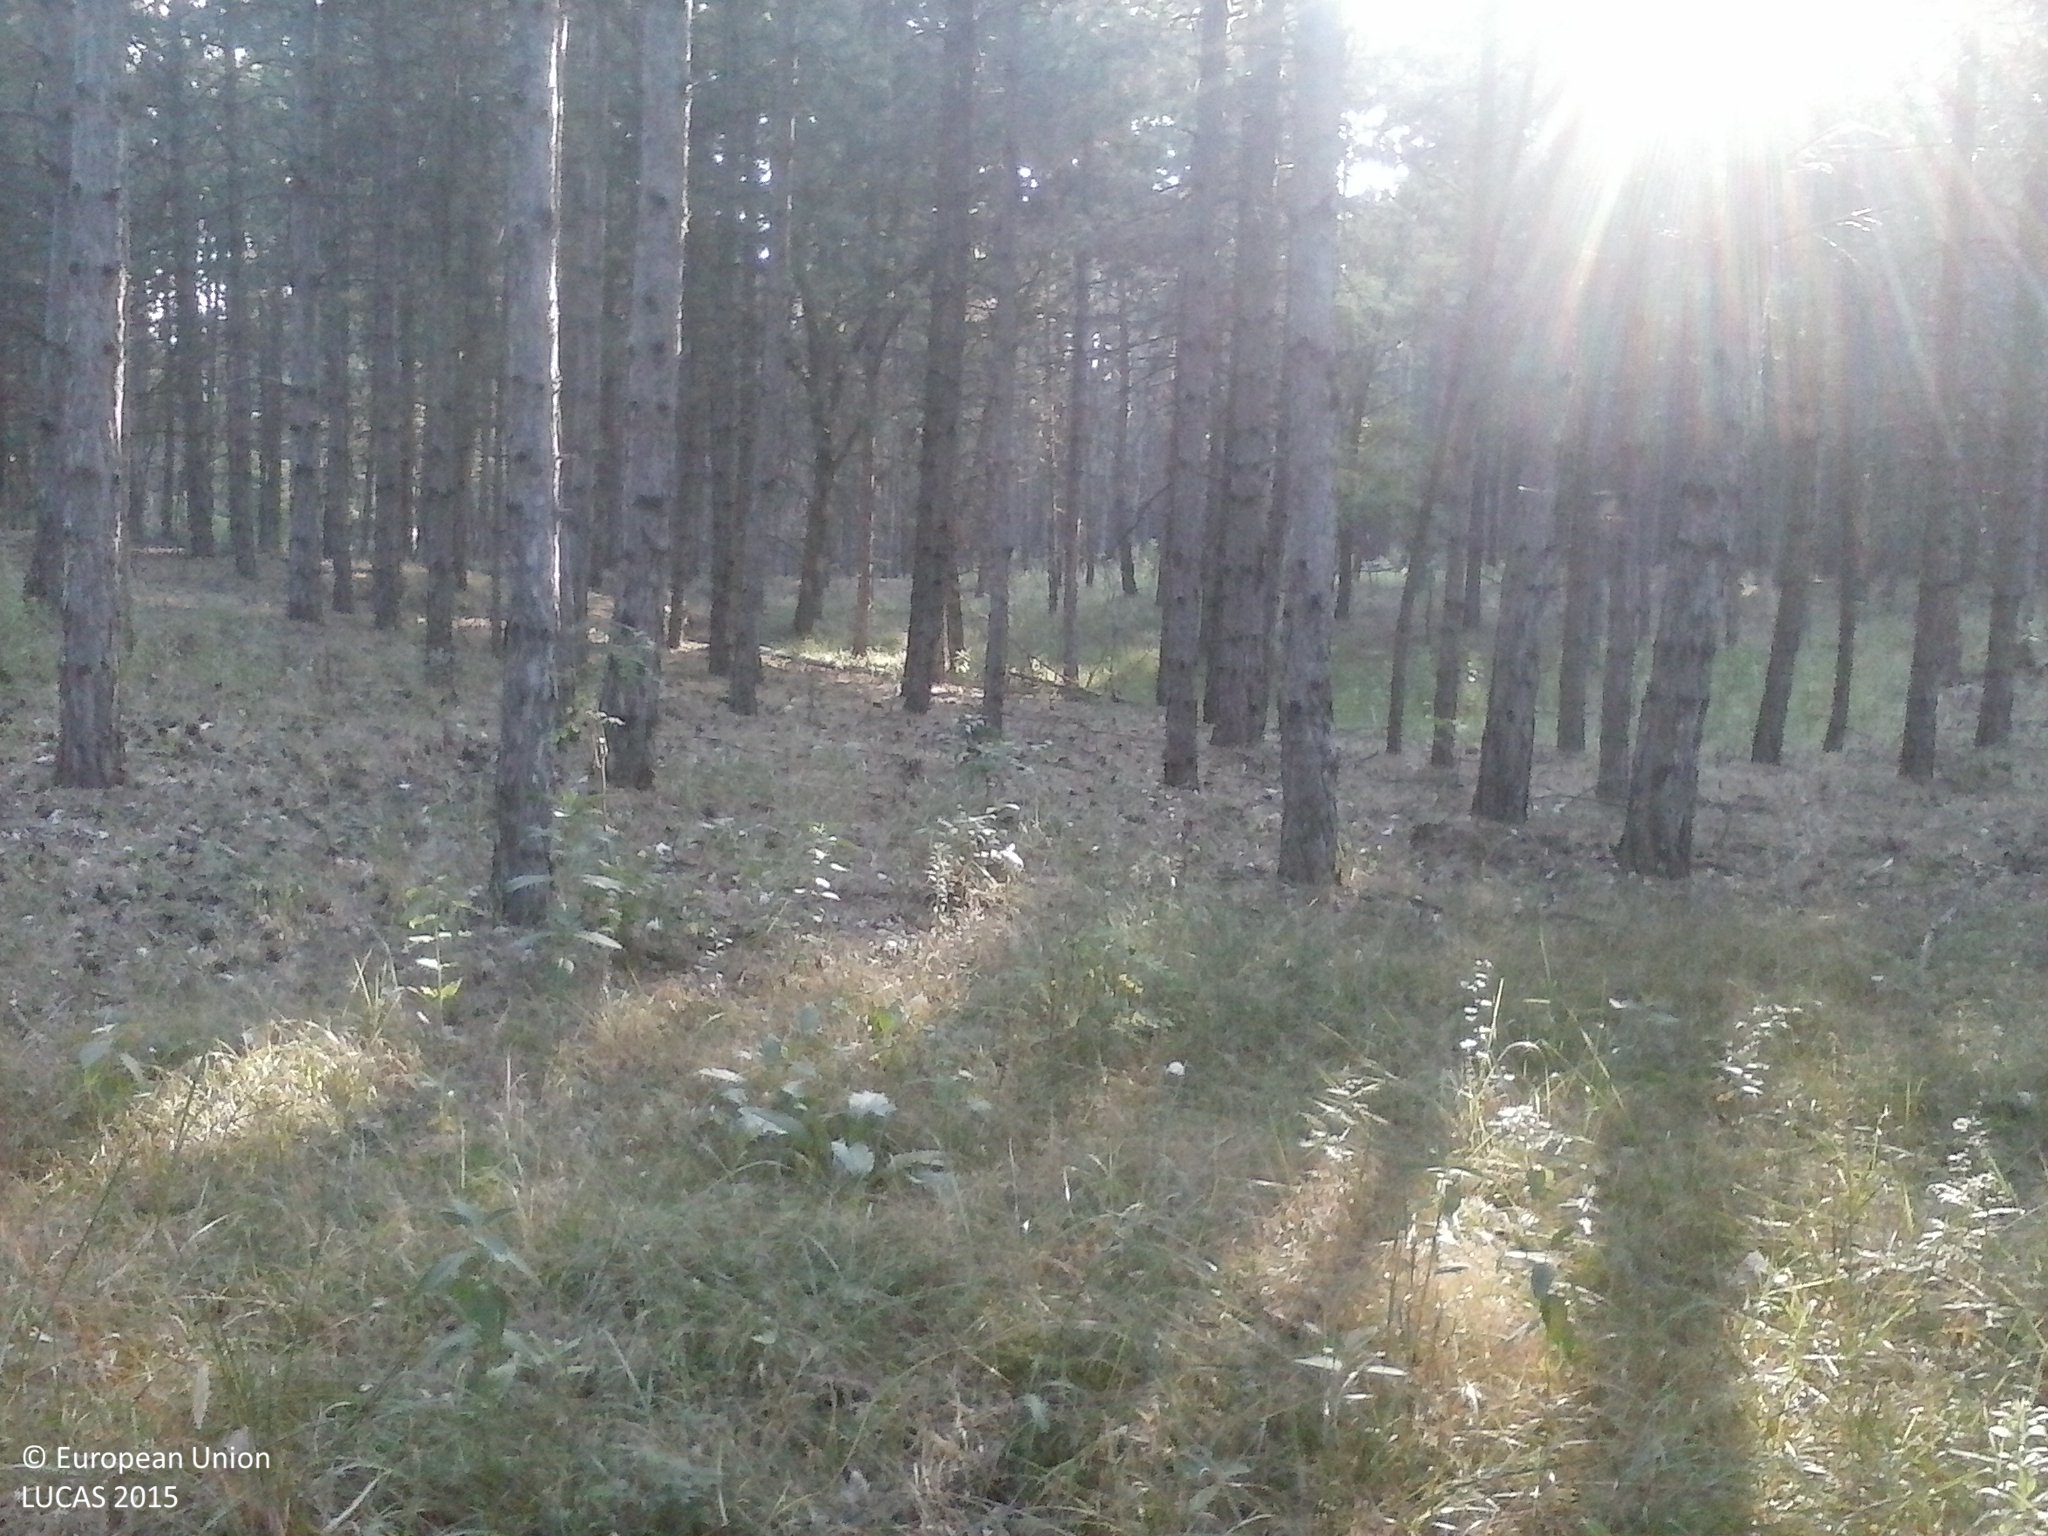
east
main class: Woodland
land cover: Pine dominated coniferous woodland
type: hemiboreal forest and nemoral coniferous forest and mixed broadleaved-coniferous forest
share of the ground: > 75 %
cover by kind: coniferous forest trees 80 %, broadleaved forest trees 10 %, shrubs 5 %, herbaceous plants 5 %
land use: Forestry
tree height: > 5 m
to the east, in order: Pine dominated coniferous woodland
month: July
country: HU
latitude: 46.4053
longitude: 19.6308
